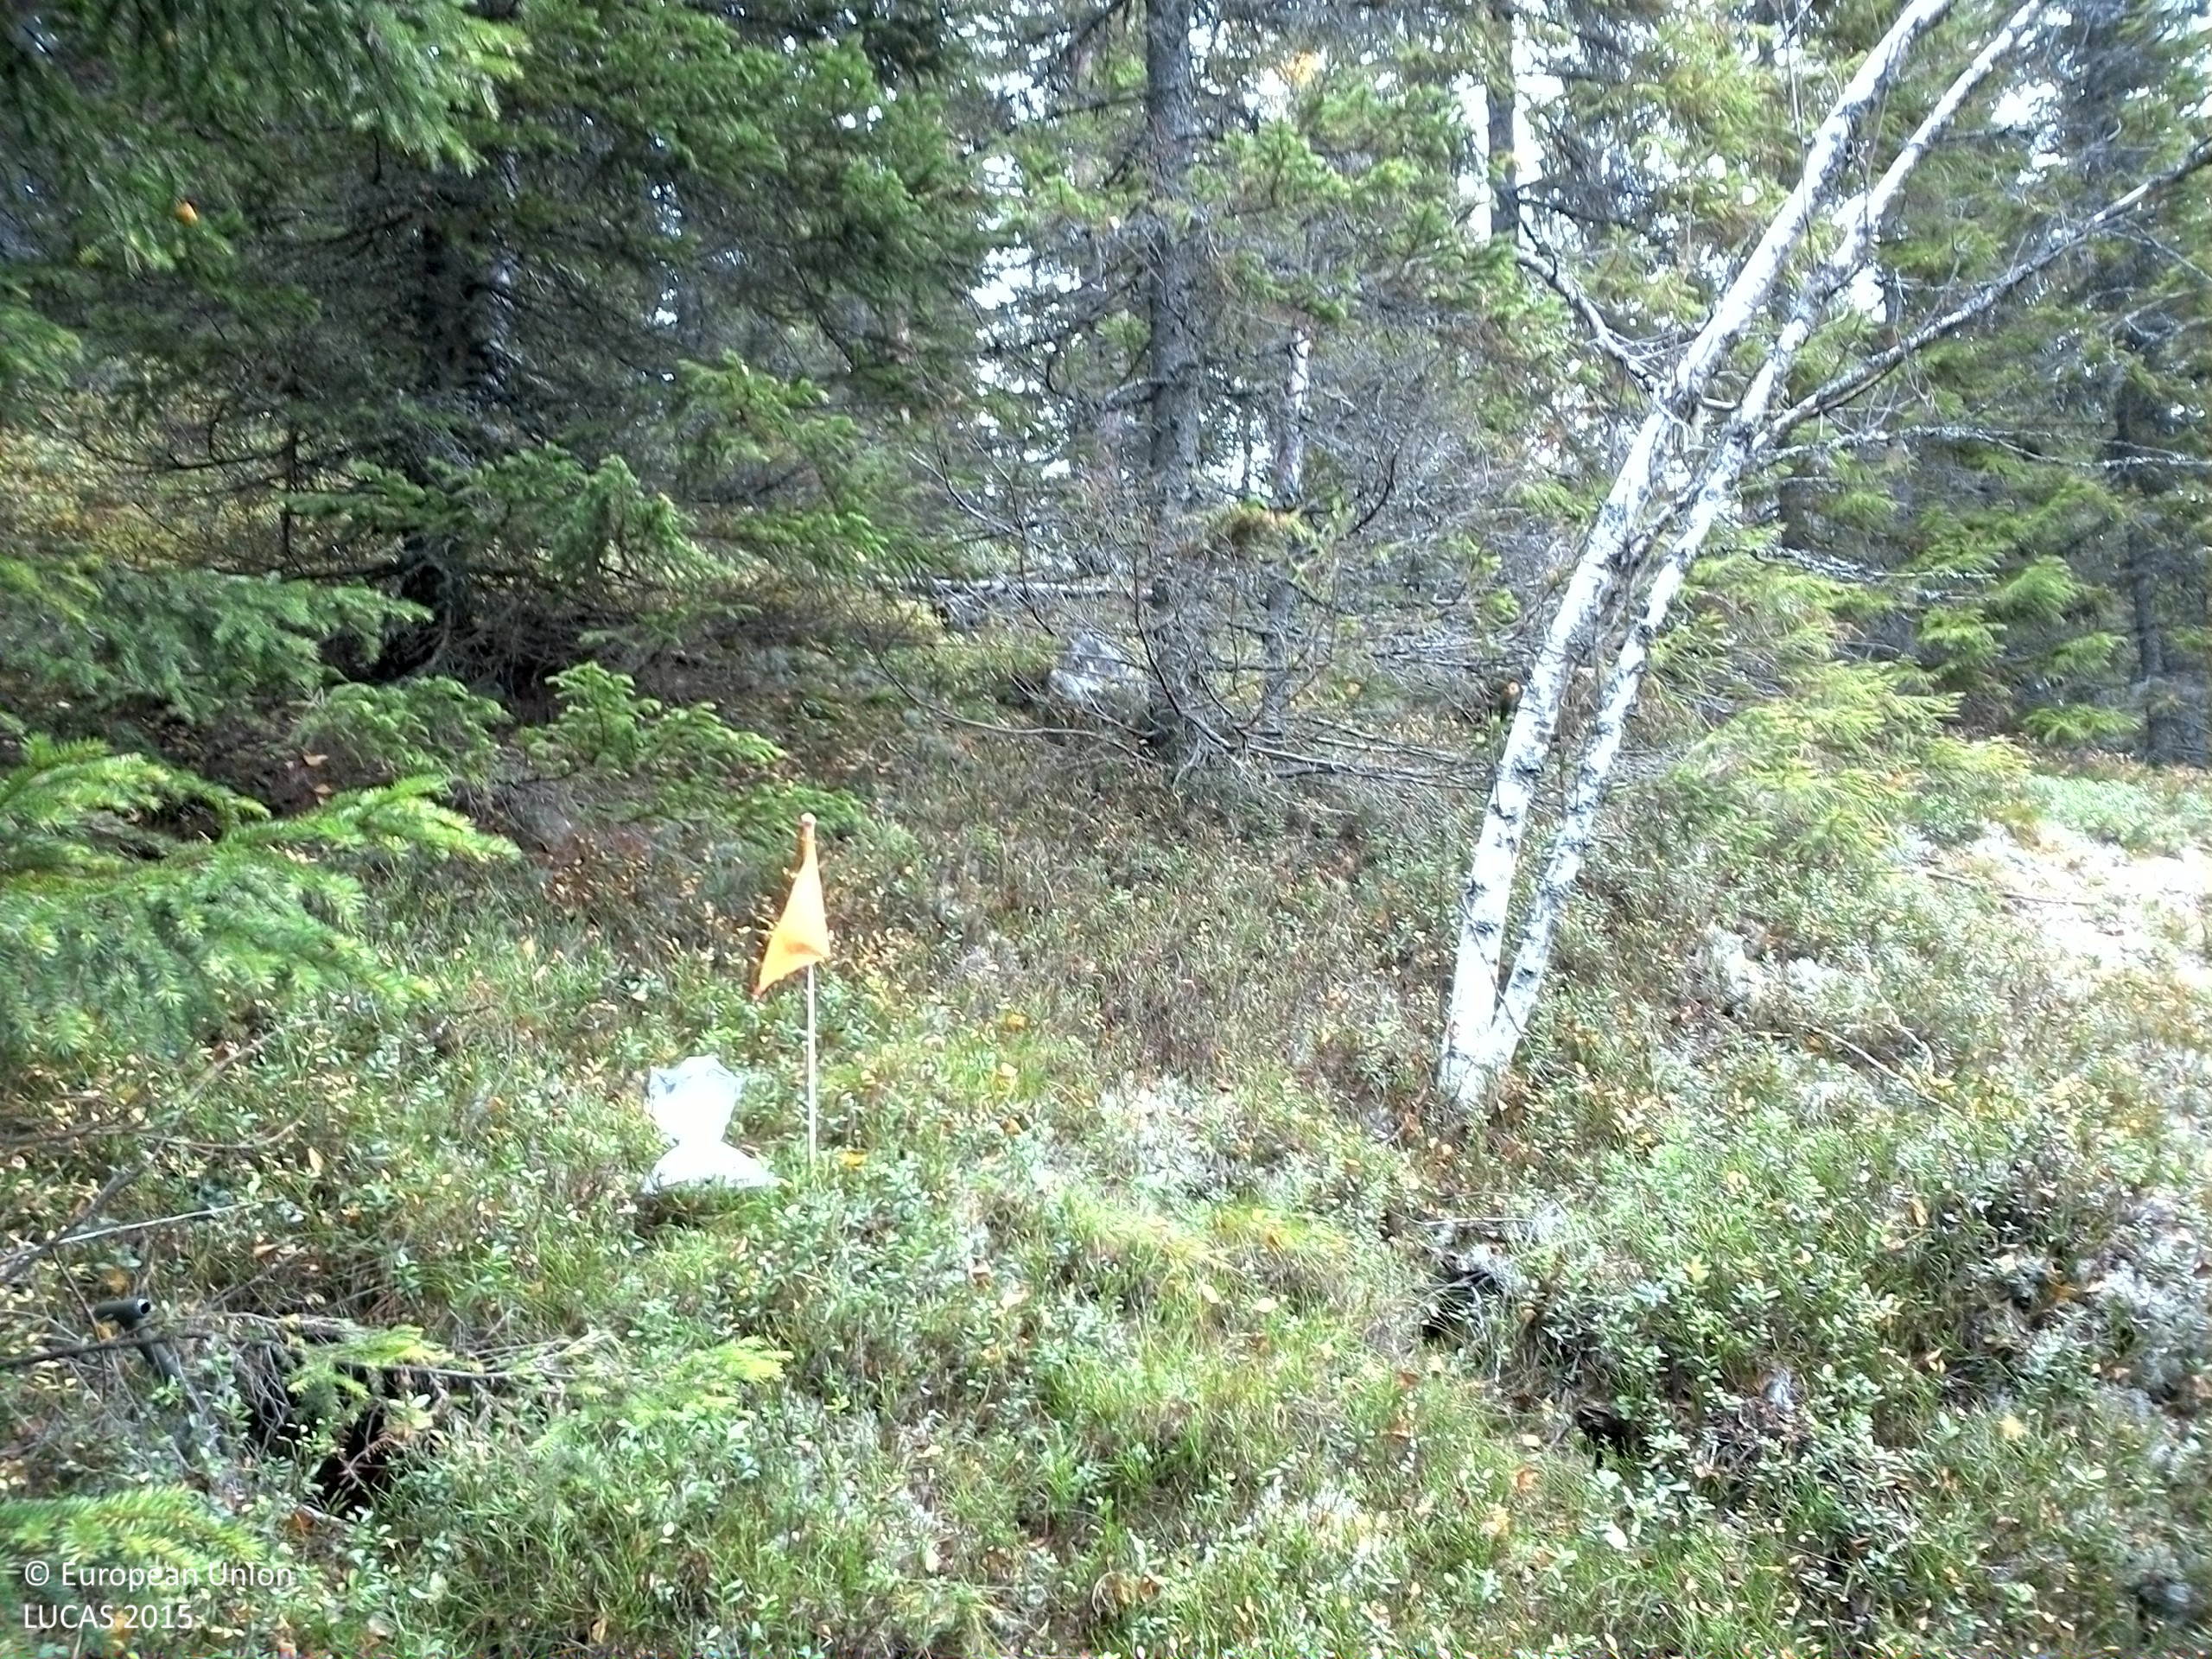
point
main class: Woodland
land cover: Spruce dominated mixed woodland
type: boreal forest
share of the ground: 50 - 75 %
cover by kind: coniferous forest trees 50 %, shrubs 30 %, broadleaved forest trees 20 %
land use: Forestry
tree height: > 5 m
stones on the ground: 10 - 25 %
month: October
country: SE
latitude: 61.4662
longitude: 14.3580
